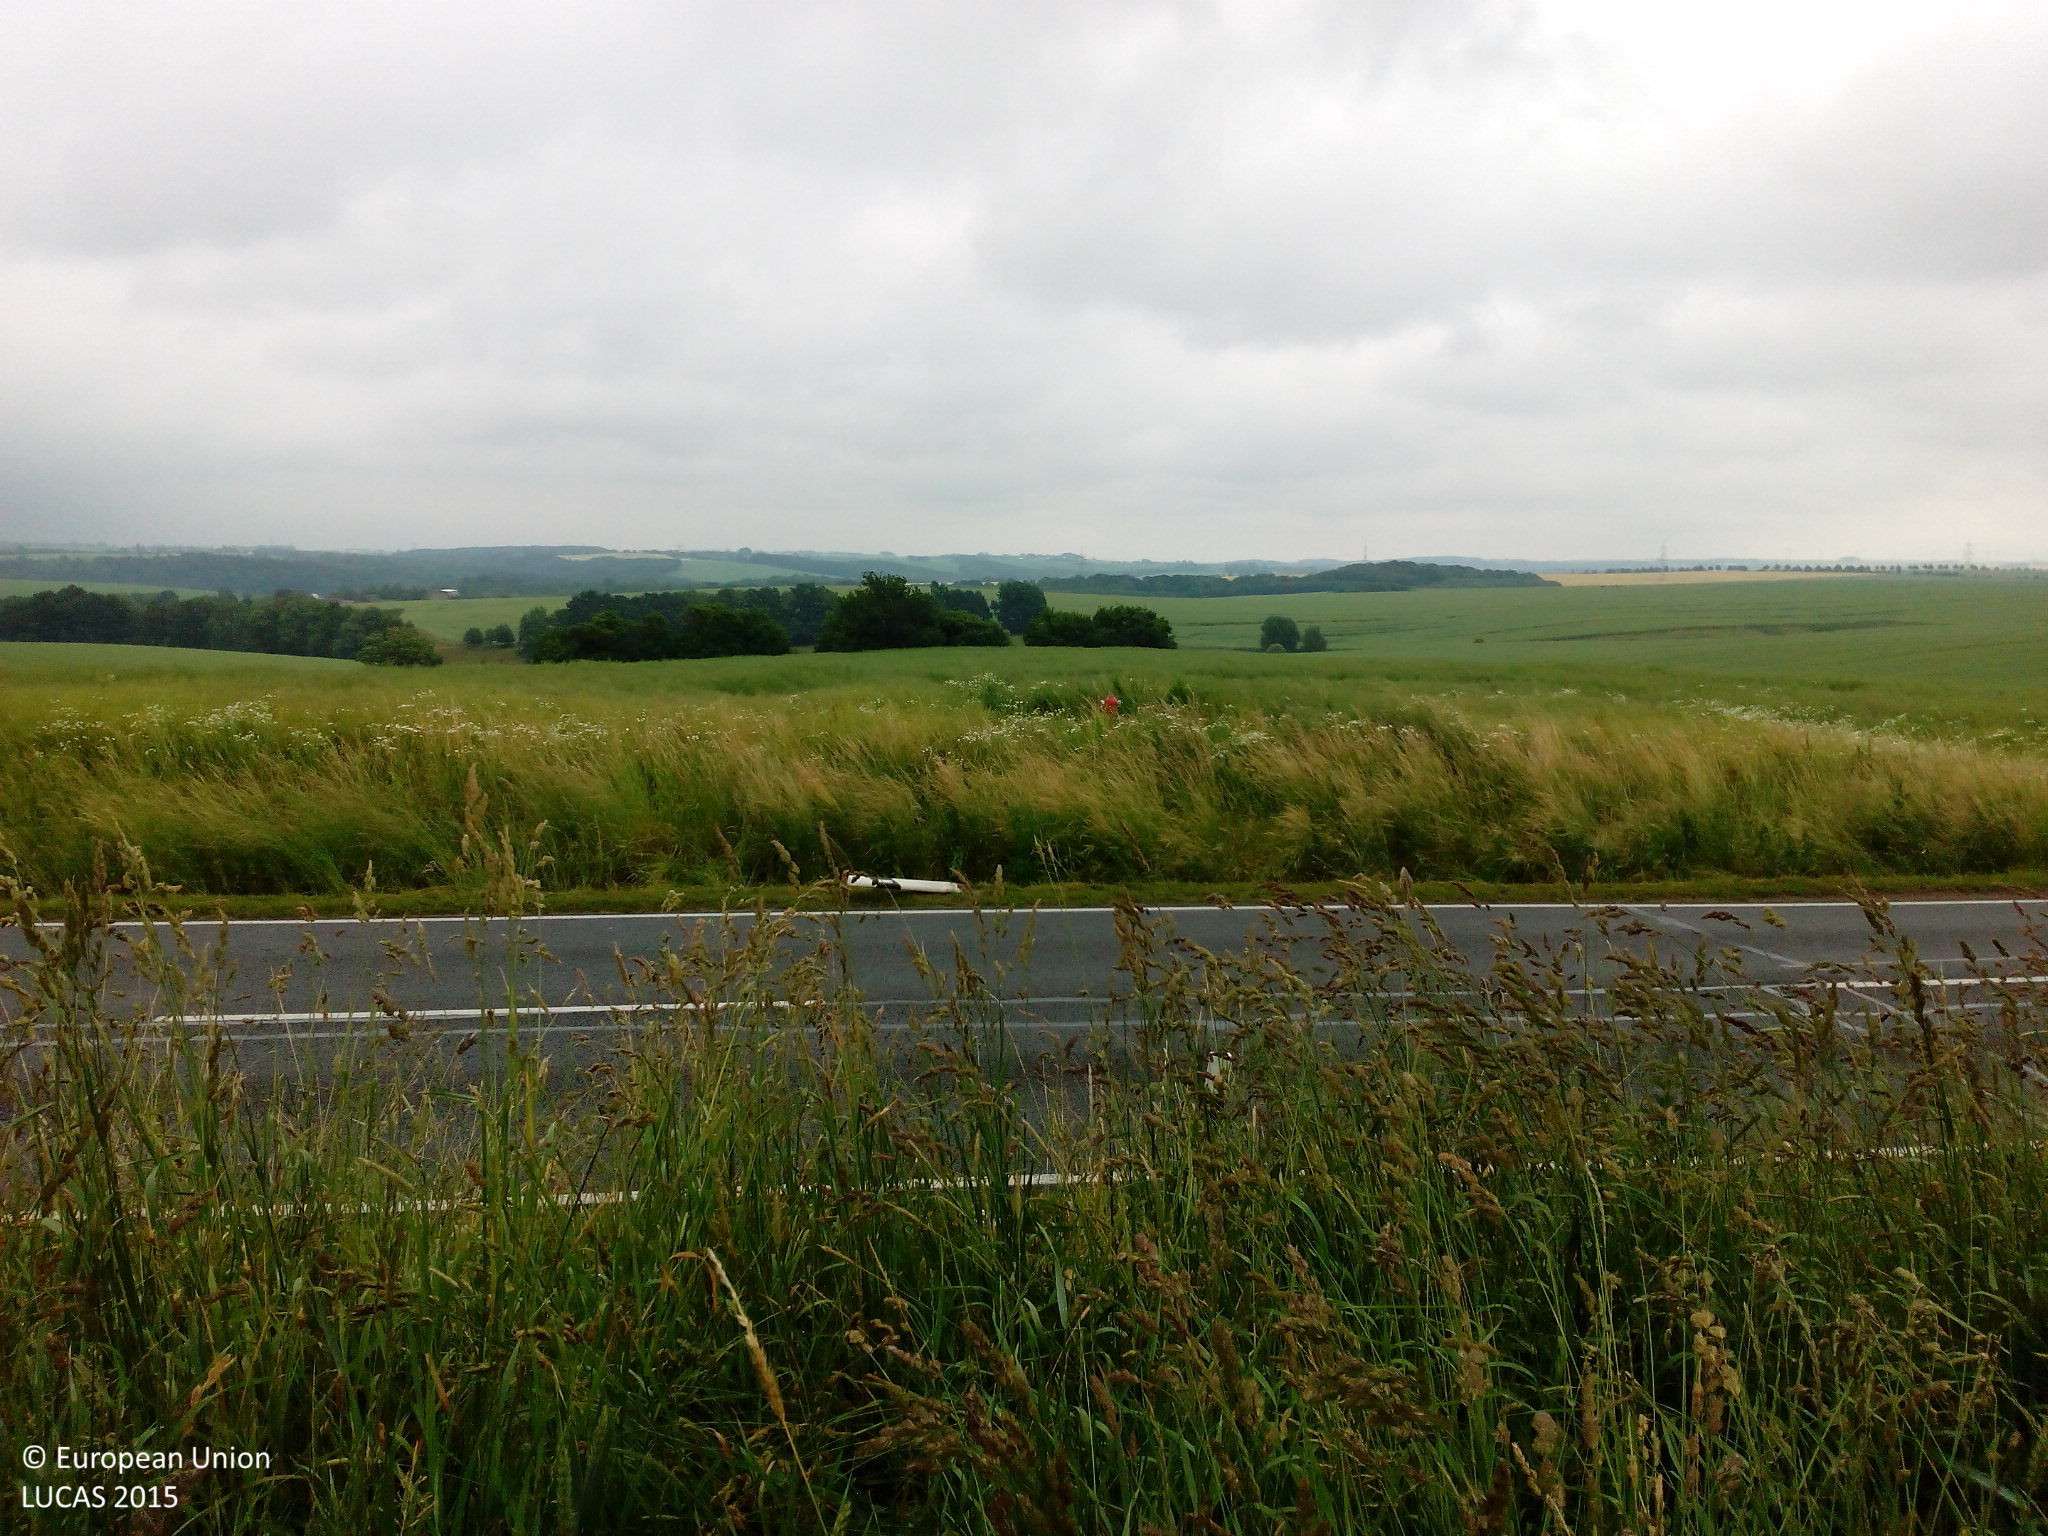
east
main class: Cropland
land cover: Common wheat
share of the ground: > 75 %
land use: Agriculture (excluding fallow land and kitchen gardens)
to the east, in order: Common wheat; Electric lines; Common wheat; Grassland without tree/shrub cover; Paved roads, cycling and walking lanes; Grassland without tree/shrub cover; Rape and turnip rape
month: June
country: DE
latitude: 51.0958
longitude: 13.0987
